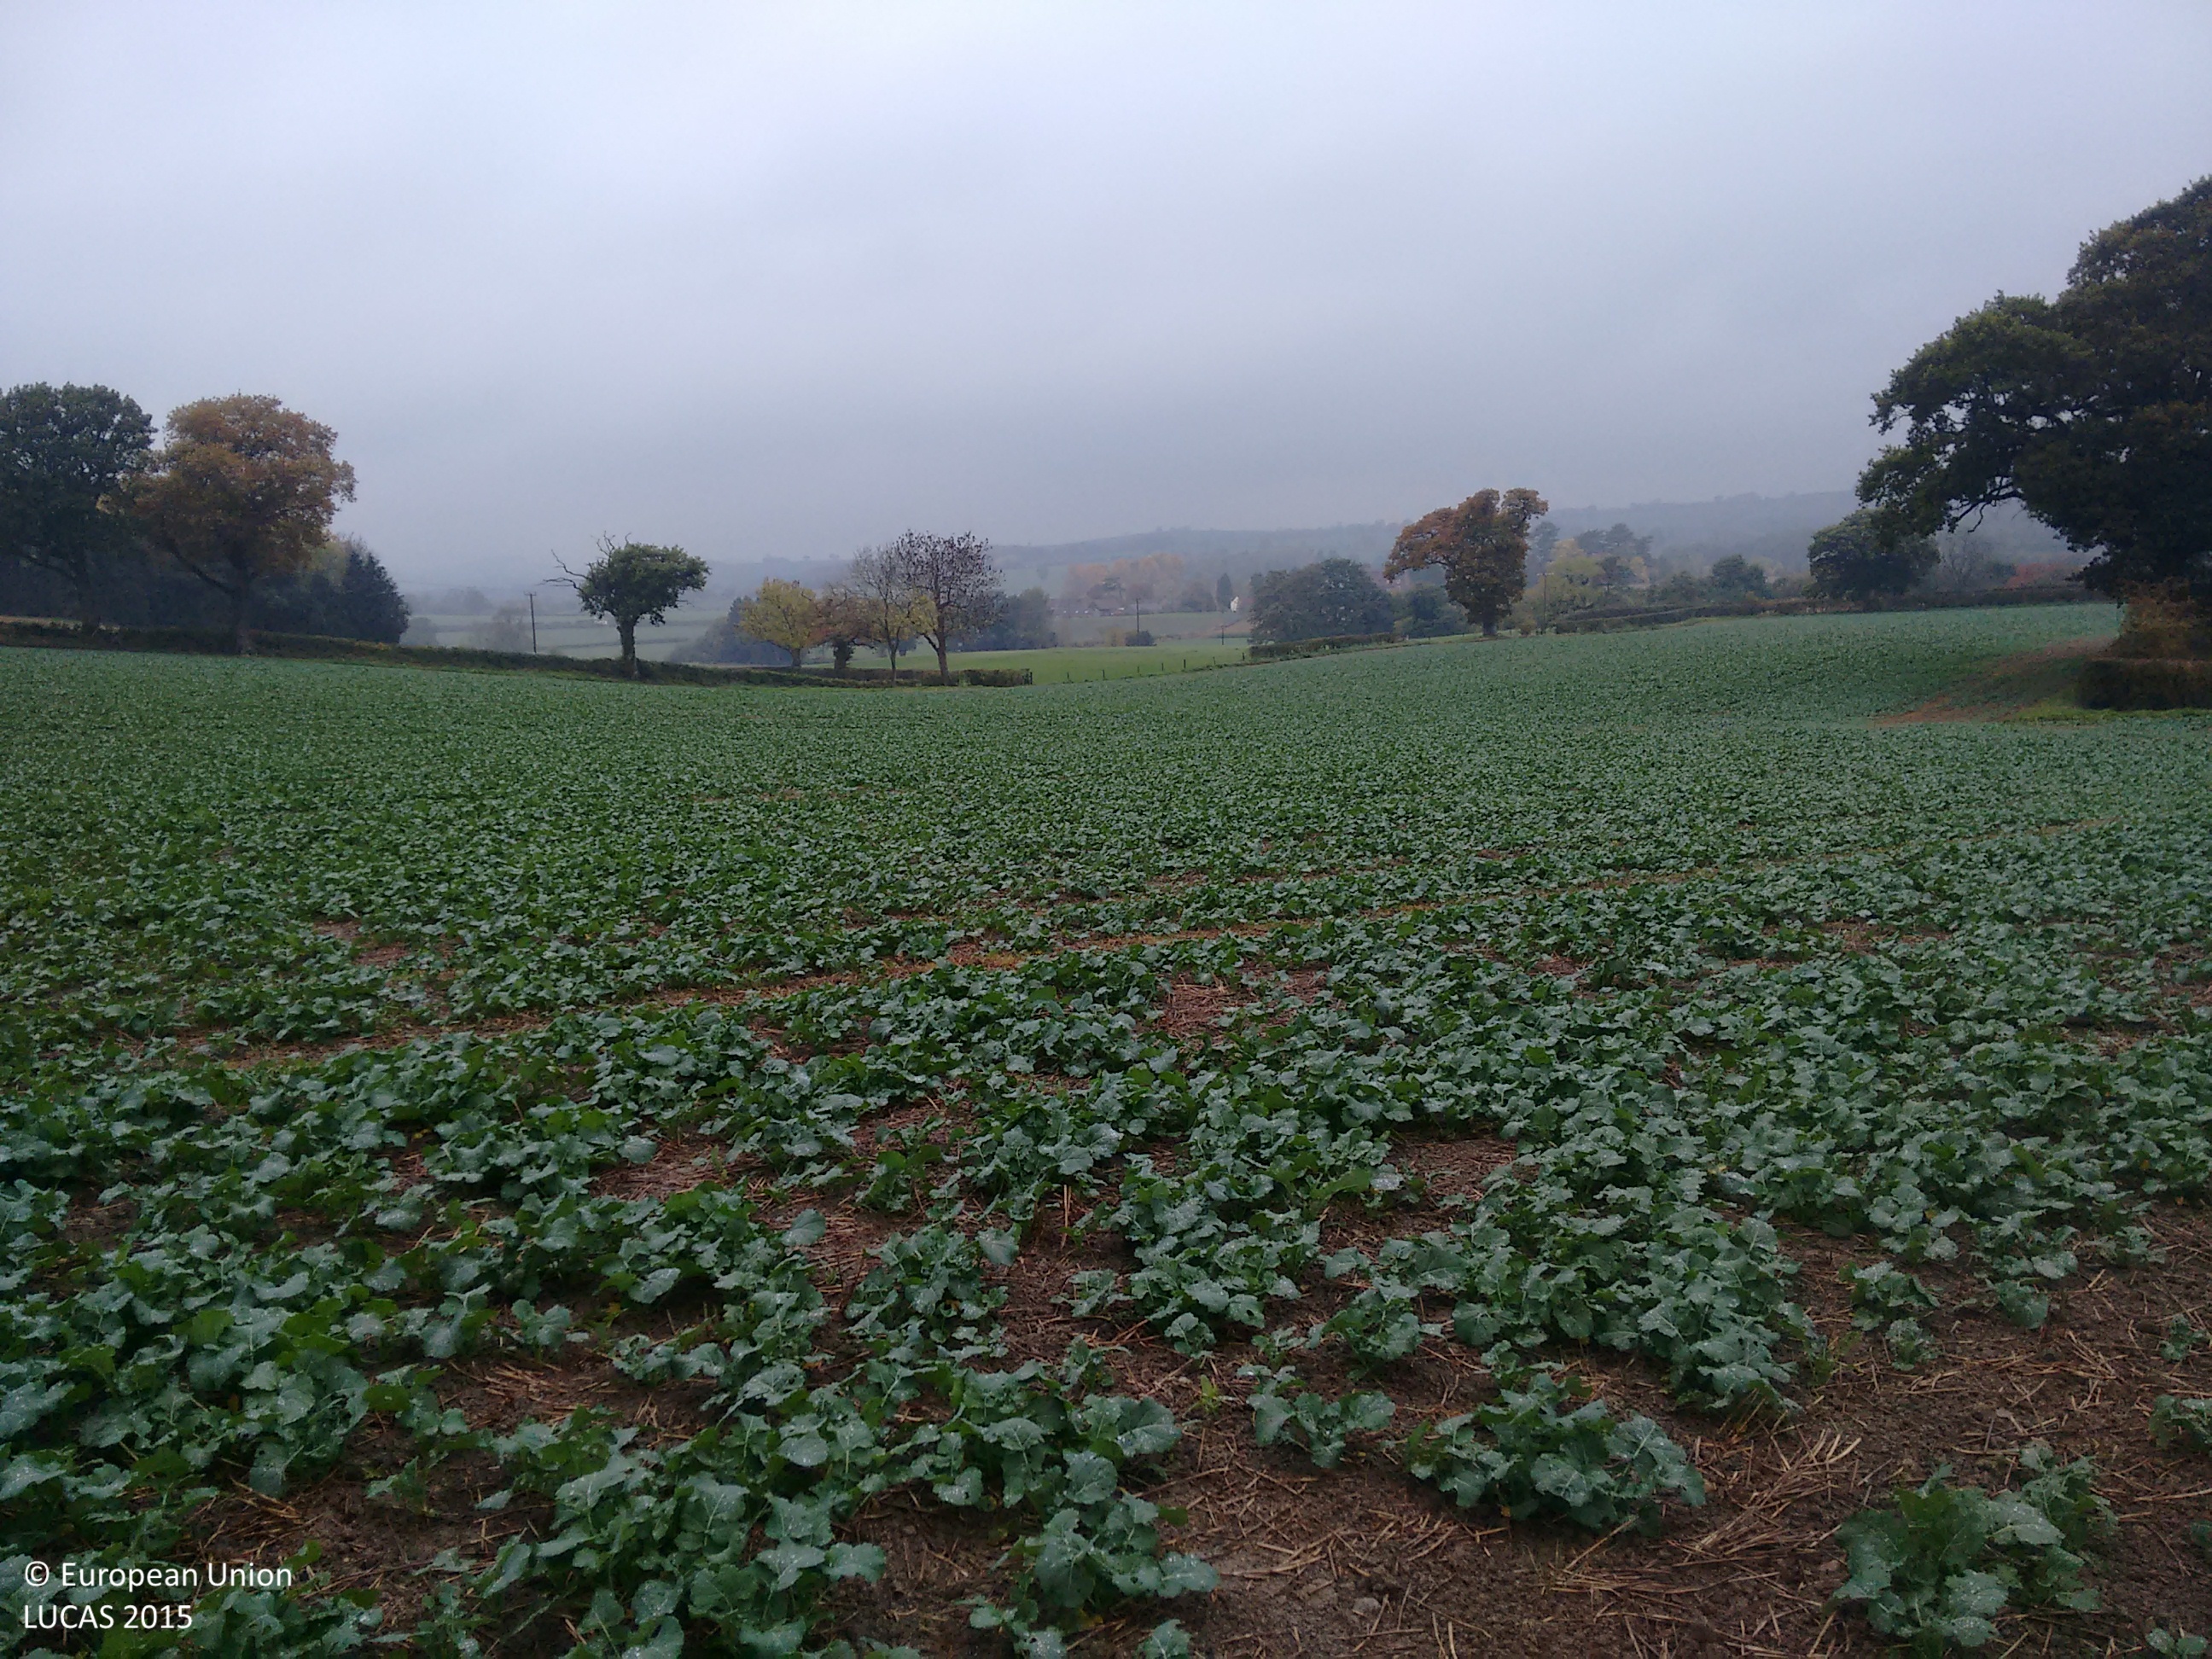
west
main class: Cropland
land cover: Rape and turnip rape
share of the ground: > 75 %
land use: Agriculture (excluding fallow land and kitchen gardens)
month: October
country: GB
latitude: 52.4814
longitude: -2.8083
